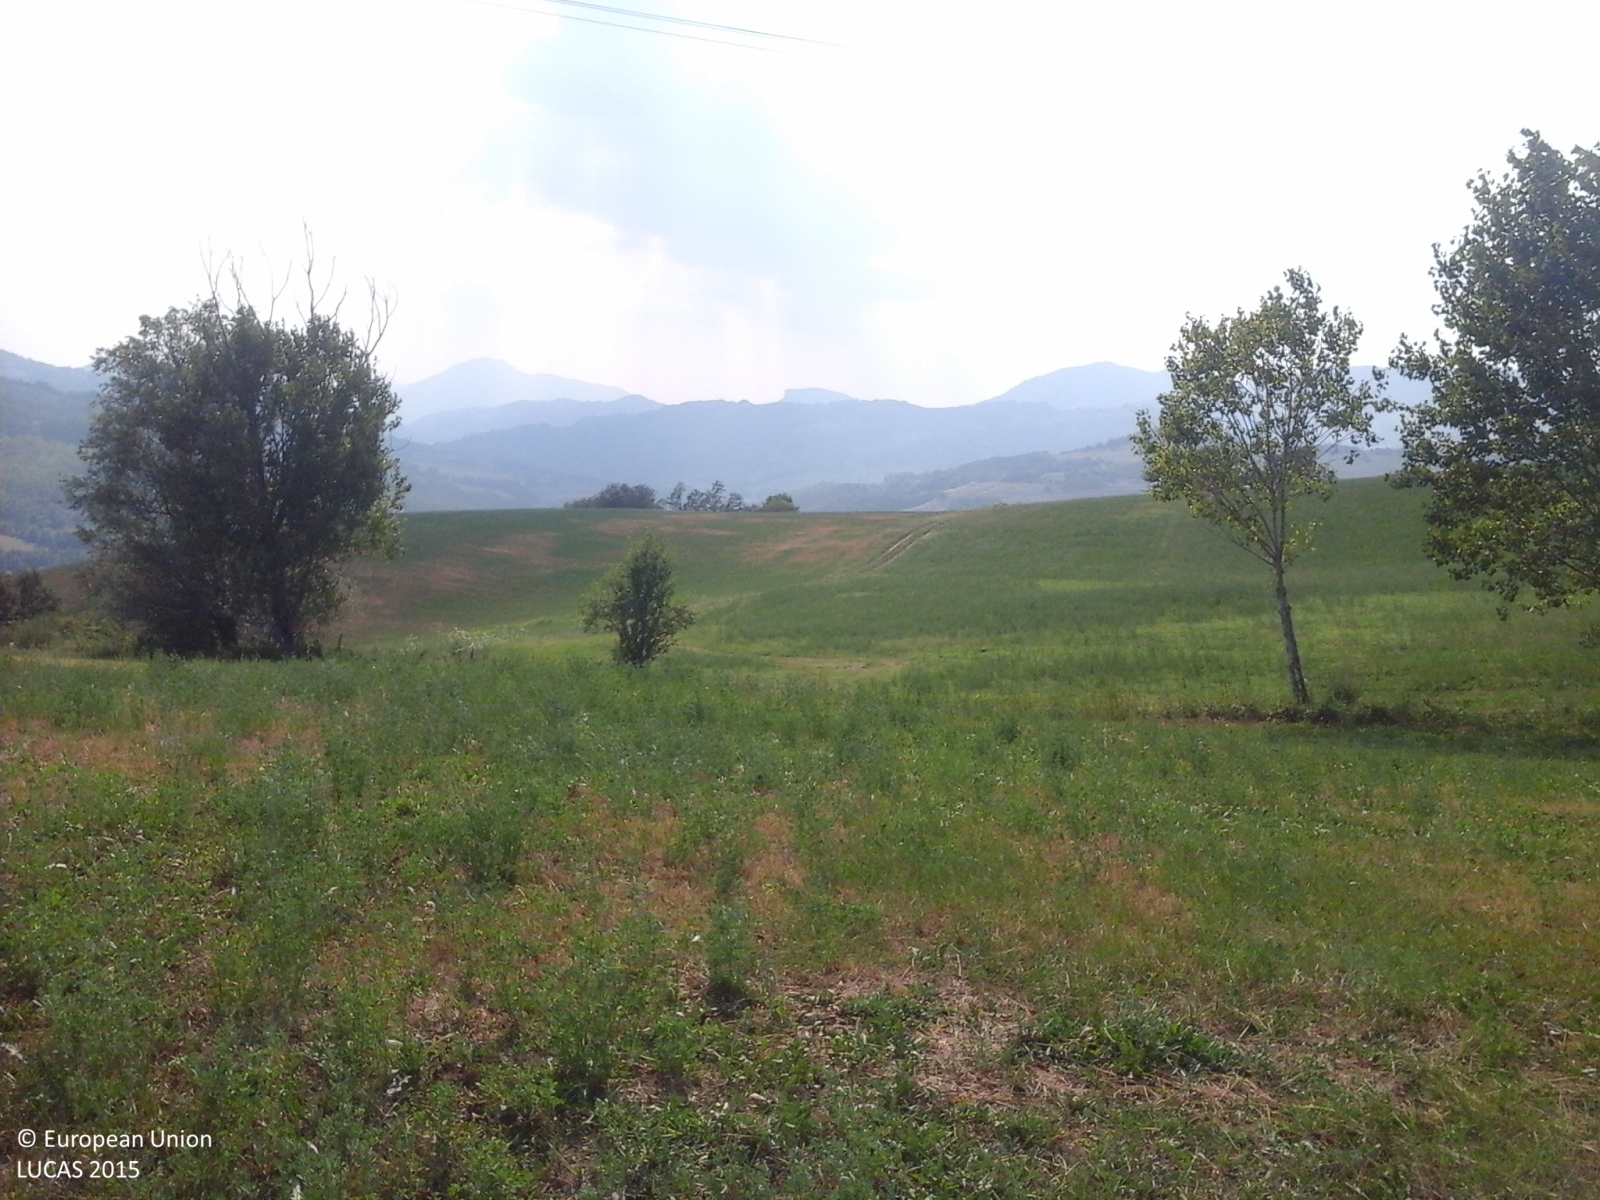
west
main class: Cropland
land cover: Lucerne
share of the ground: > 75 %
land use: Agriculture (excluding fallow land and kitchen gardens)
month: July
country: IT
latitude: 44.4210
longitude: 10.5890
